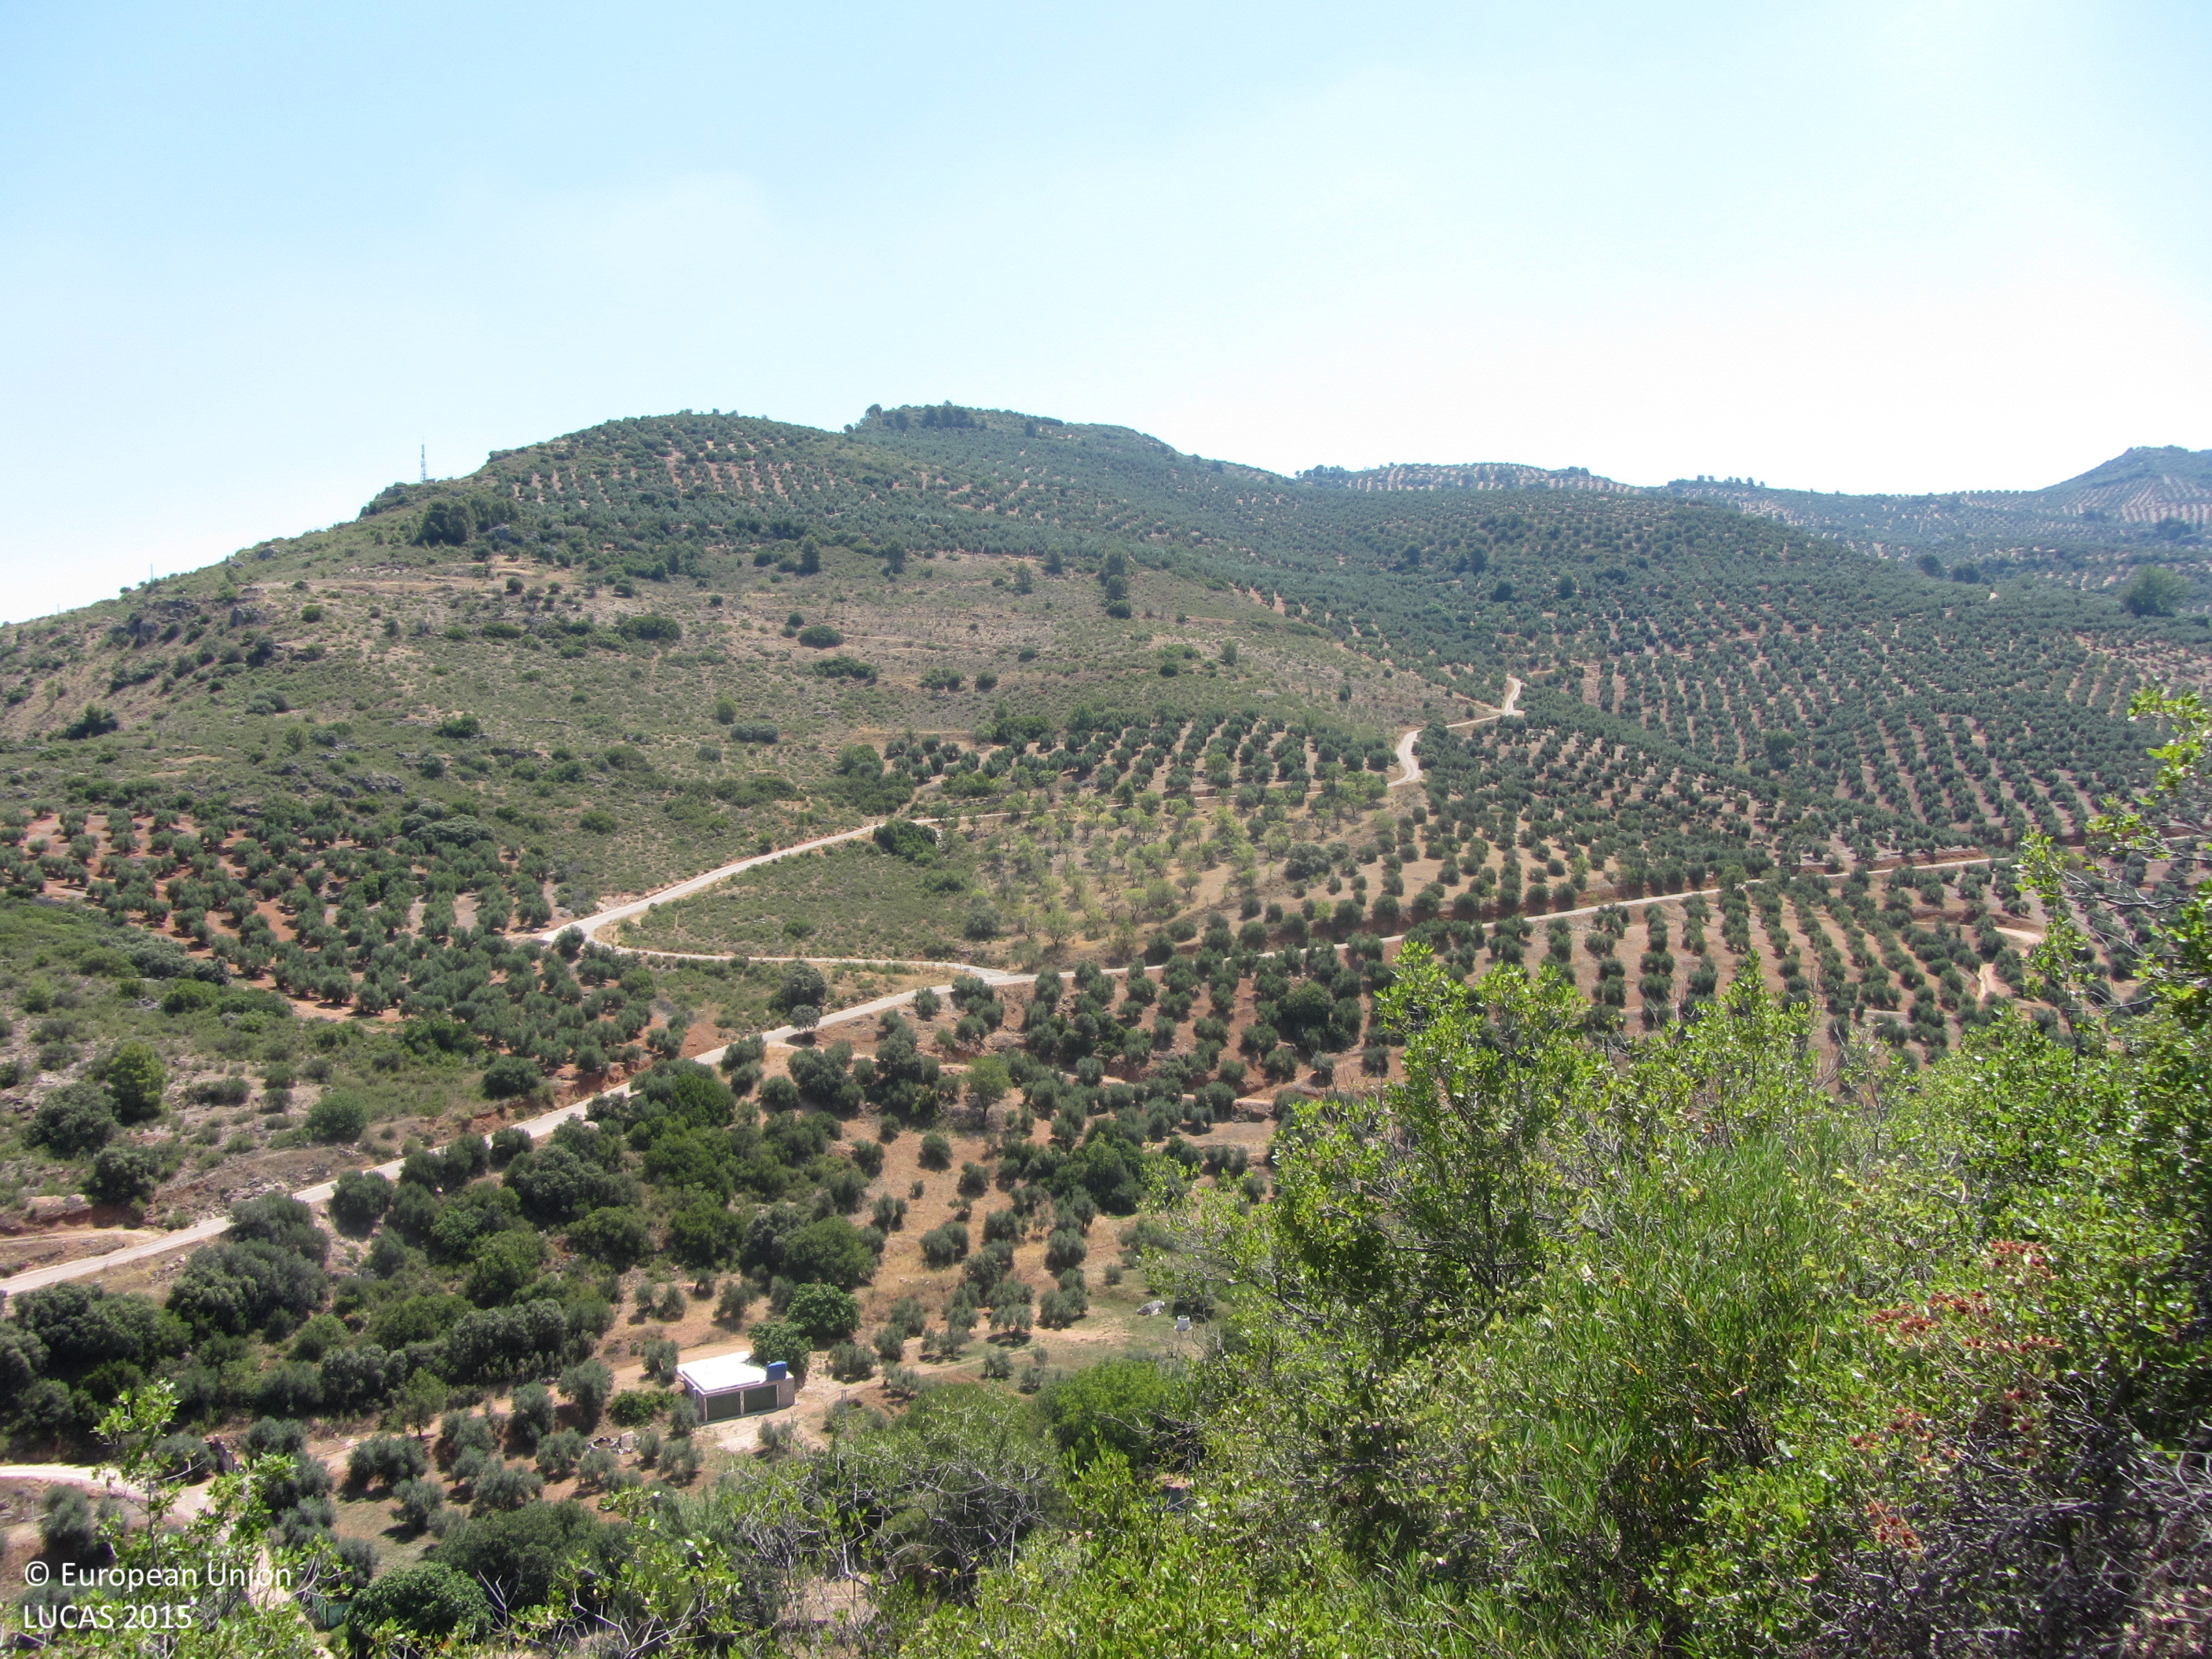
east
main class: Shrubland
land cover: Shrubland with sparse tree cover
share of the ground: > 75 %
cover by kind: shrubs 95 %, coniferous forest trees 5 %
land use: Semi-natural and natural areas not in use
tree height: < 5 m
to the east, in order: Shrubland with sparse tree cover; Shrubland without tree cover; Shrubland with sparse tree cover; Broadleaved woodland; Grassland with sparse tree/shrub cover; Shruby margins; Other bare soil; Groves; Shrubland with sparse tree cover; Tracks; Fences; Shruby margins; Rivers and streams; Shruby margins; Fences; Tracks; Olive groves; Fences; Tracks; Olive groves; Fences; Tracks; Olive groves
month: June
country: ES
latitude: 38.2432
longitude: -2.8757
